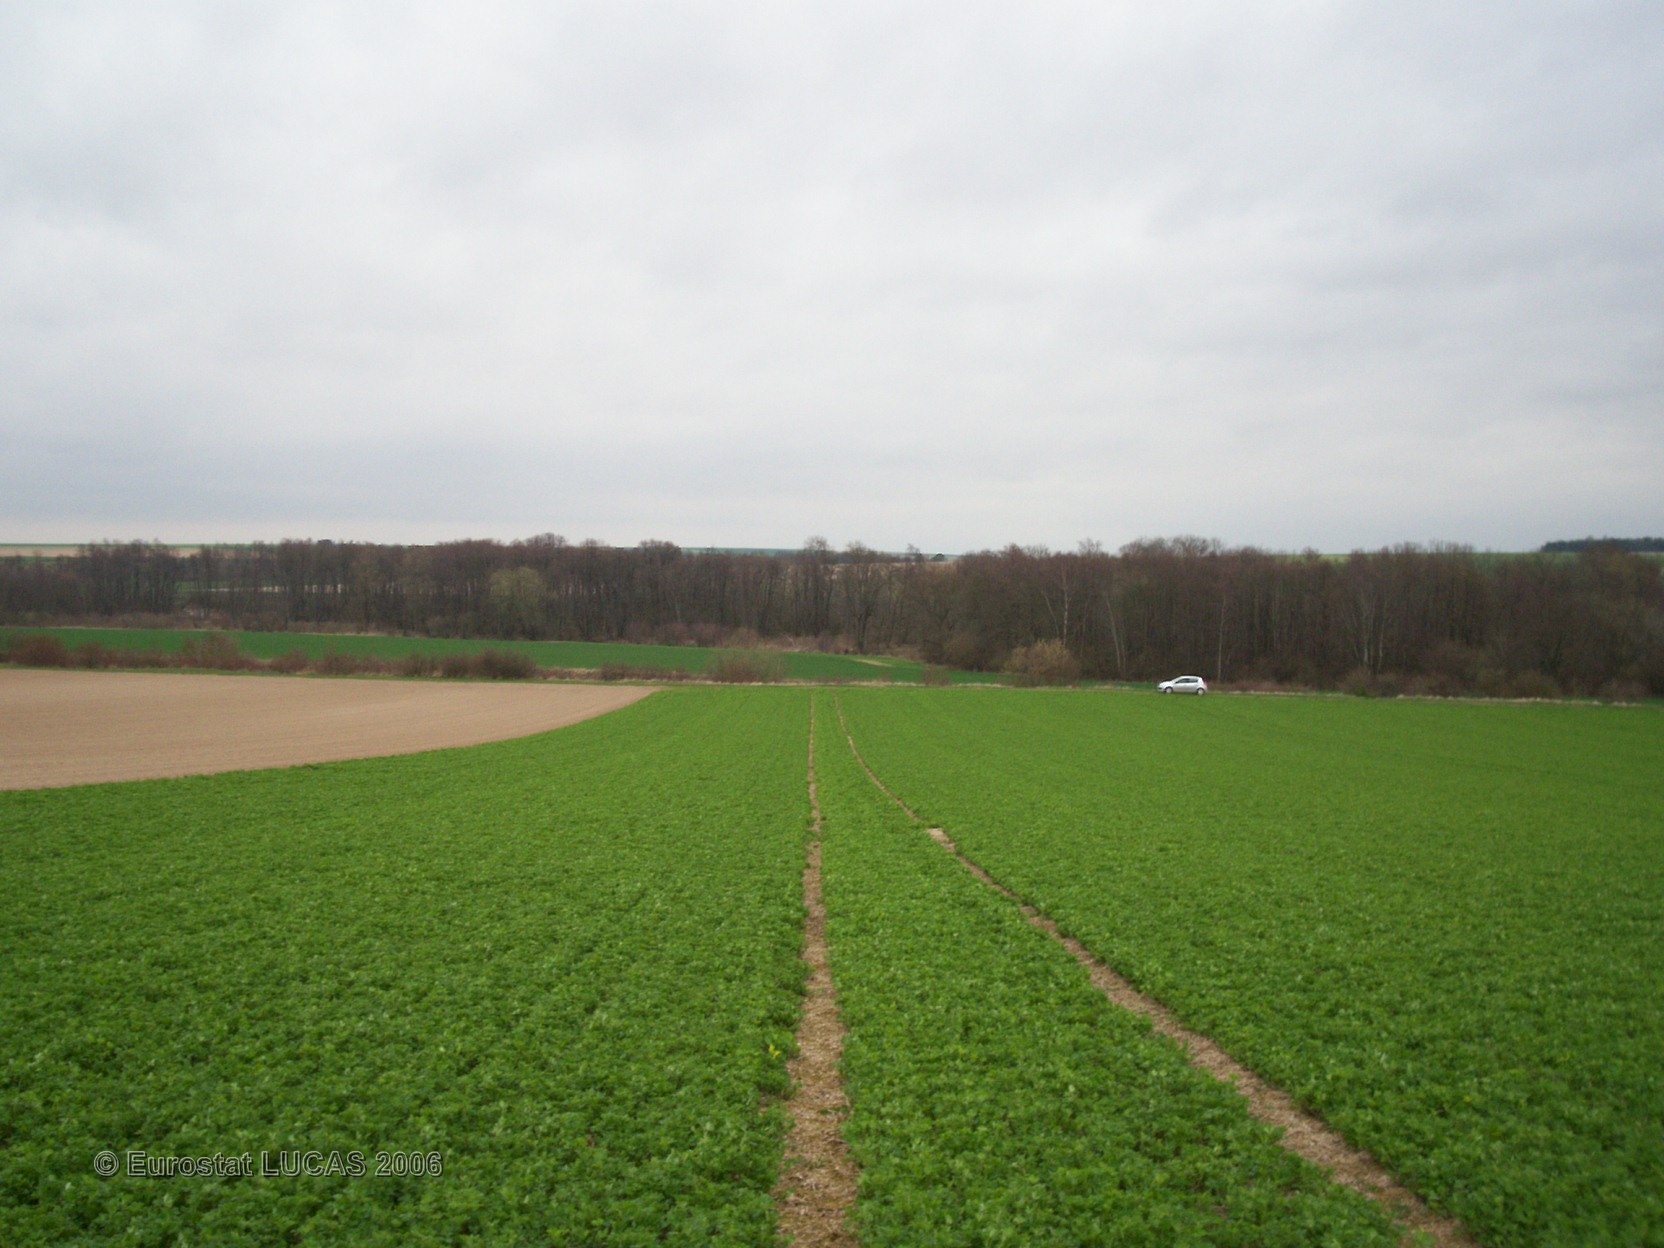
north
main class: Cropland
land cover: Lucerne
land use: Agriculture (excluding fallow land and kitchen gardens)
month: April
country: FR
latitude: 49.2371
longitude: 4.4339
